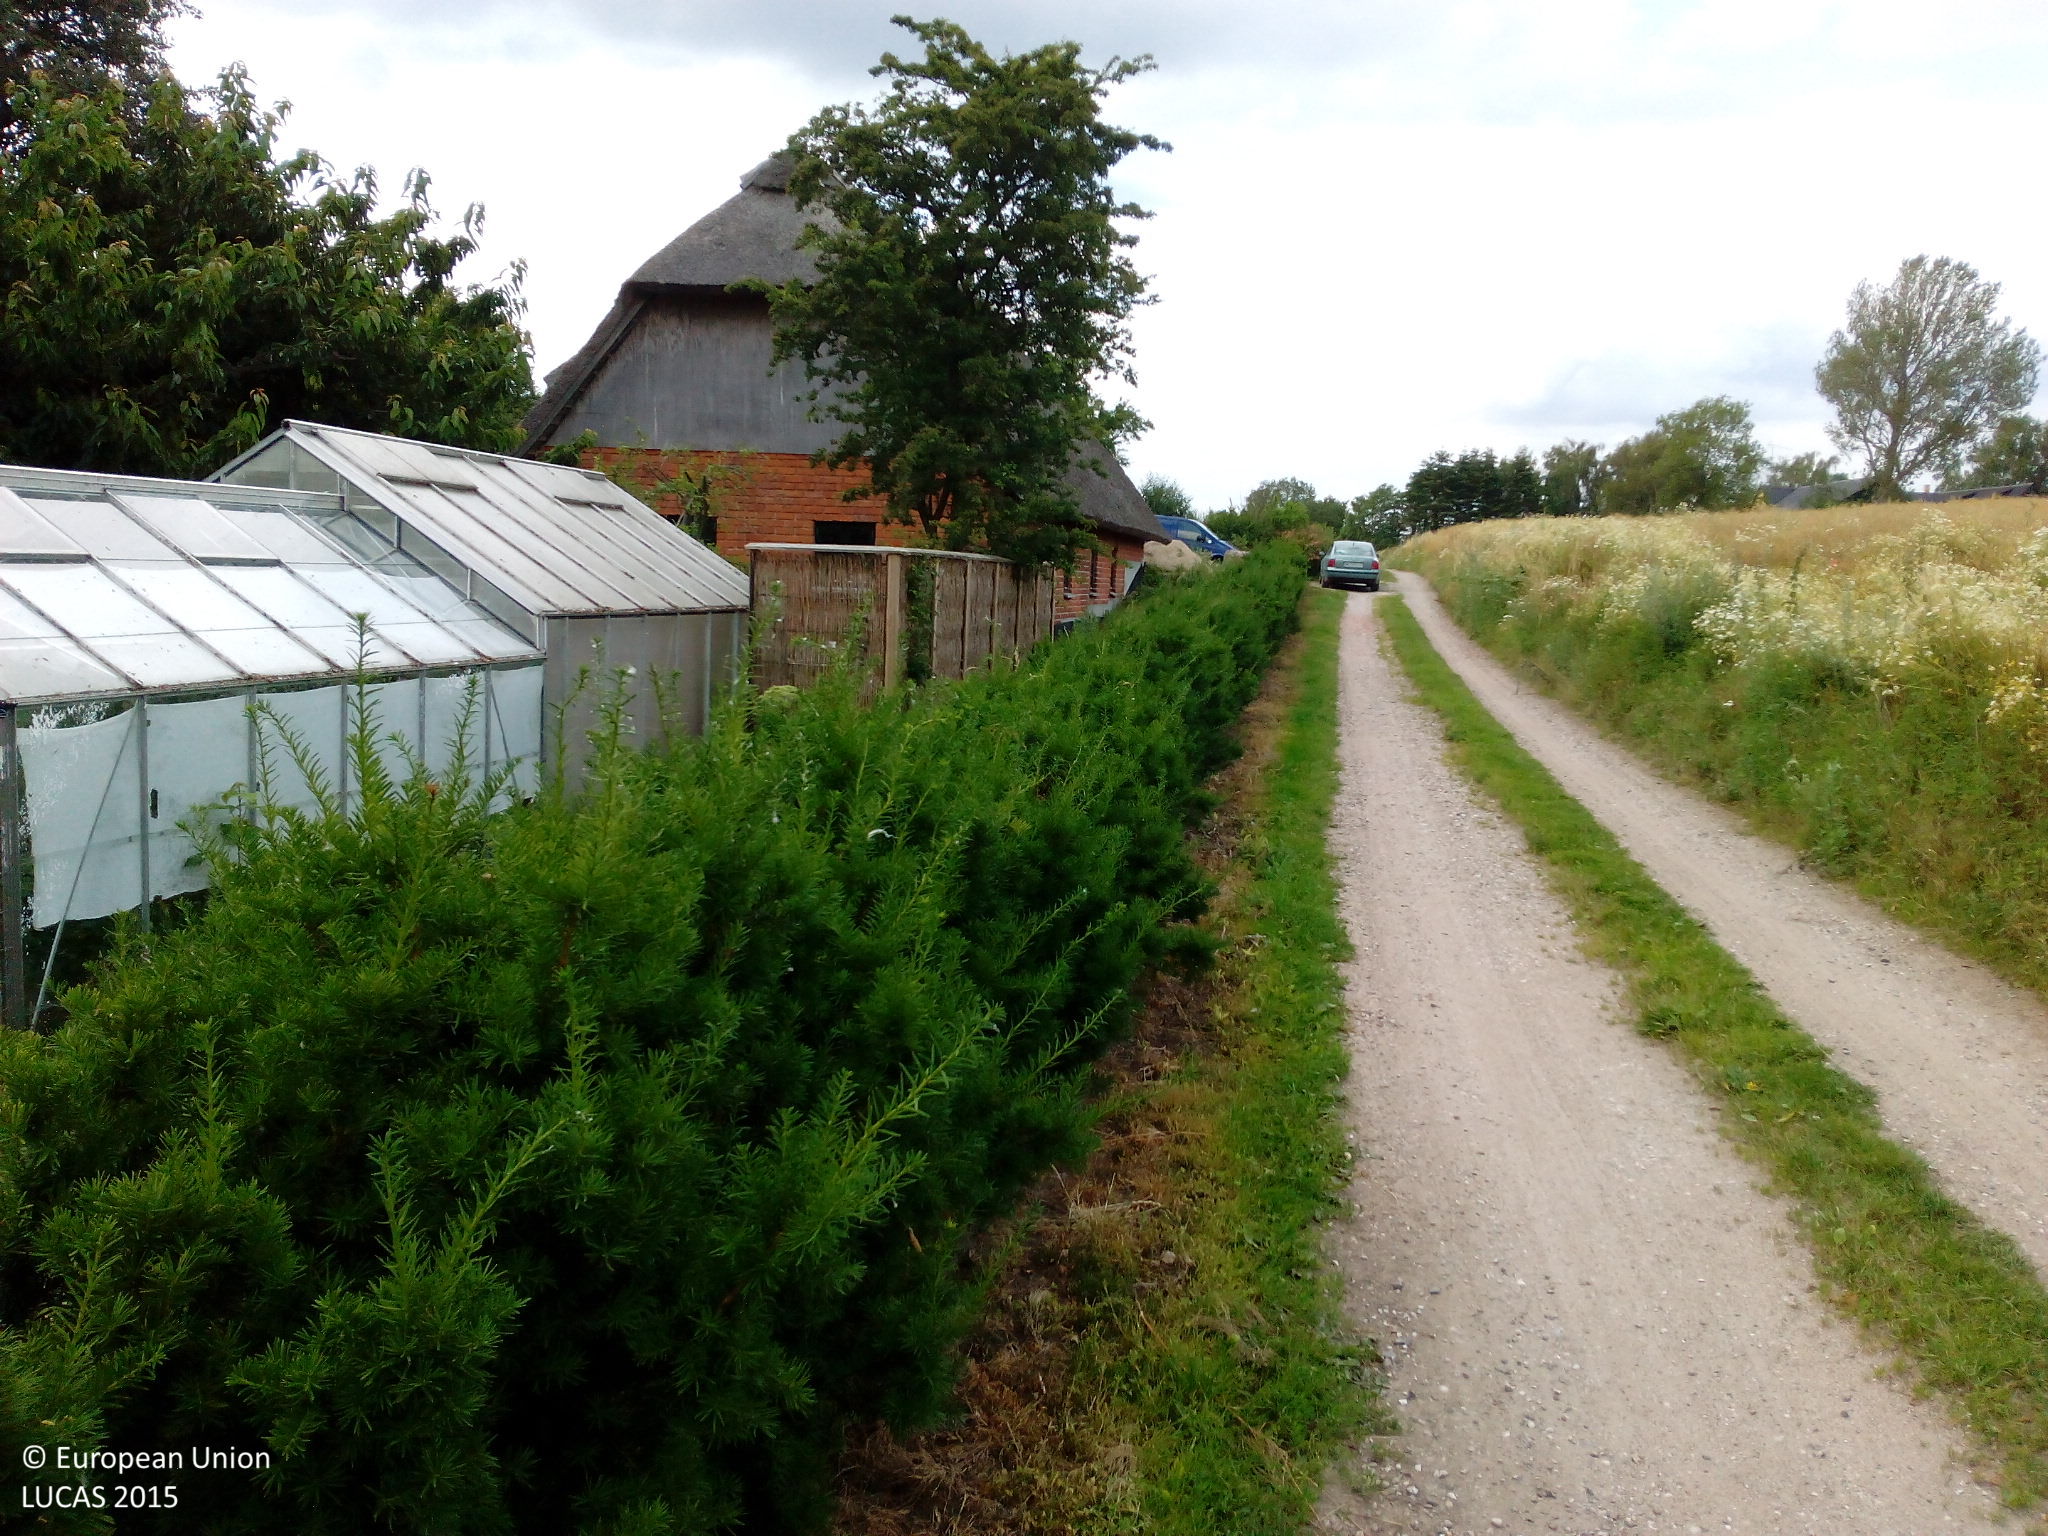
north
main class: Cropland
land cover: Rape and turnip rape
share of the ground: > 75 %
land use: Agriculture (excluding fallow land and kitchen gardens)
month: July
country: DK
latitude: 55.7787
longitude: 11.8637
